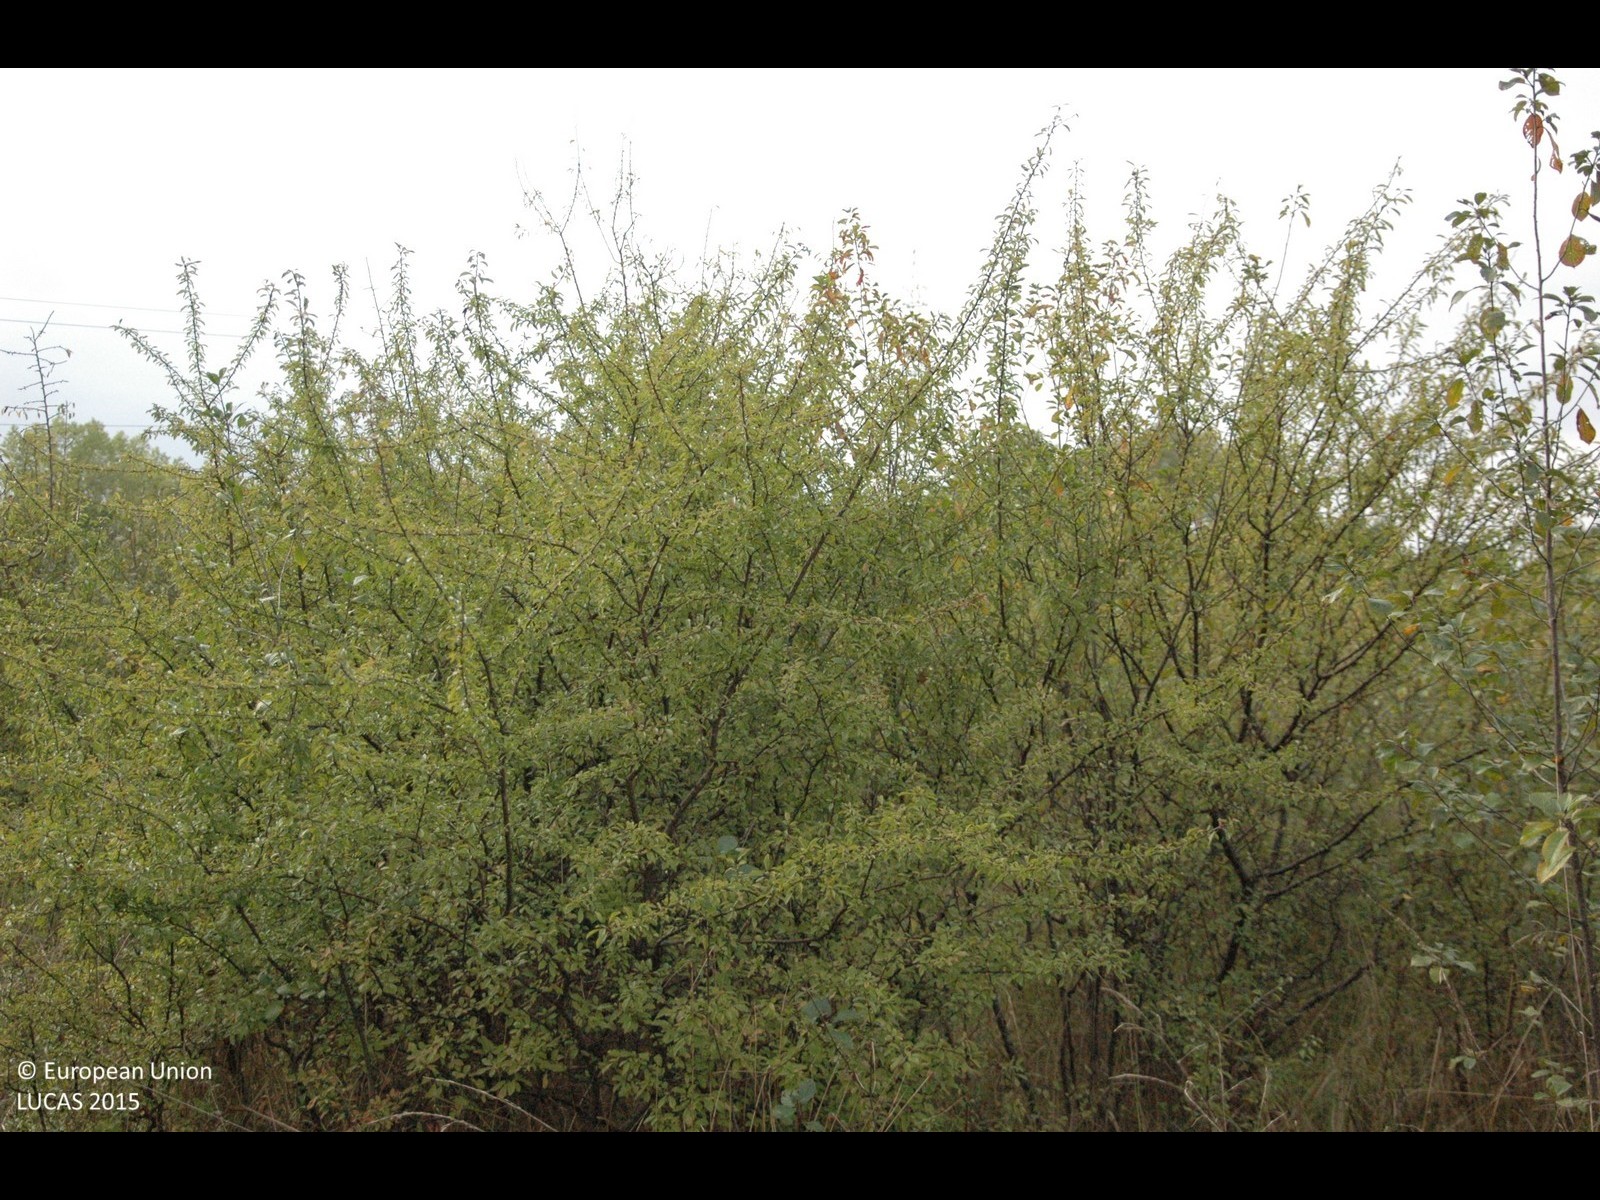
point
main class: Artificial land
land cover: Non built-up linear features
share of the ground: 10 - 25 %
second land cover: Spontaneously vegetated surfaces
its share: > 75 %
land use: Electricity, gas and thermal power distribution
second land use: Protection infrastructures
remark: Clear cut
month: October
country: HR
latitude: 45.5744
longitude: 16.2128
